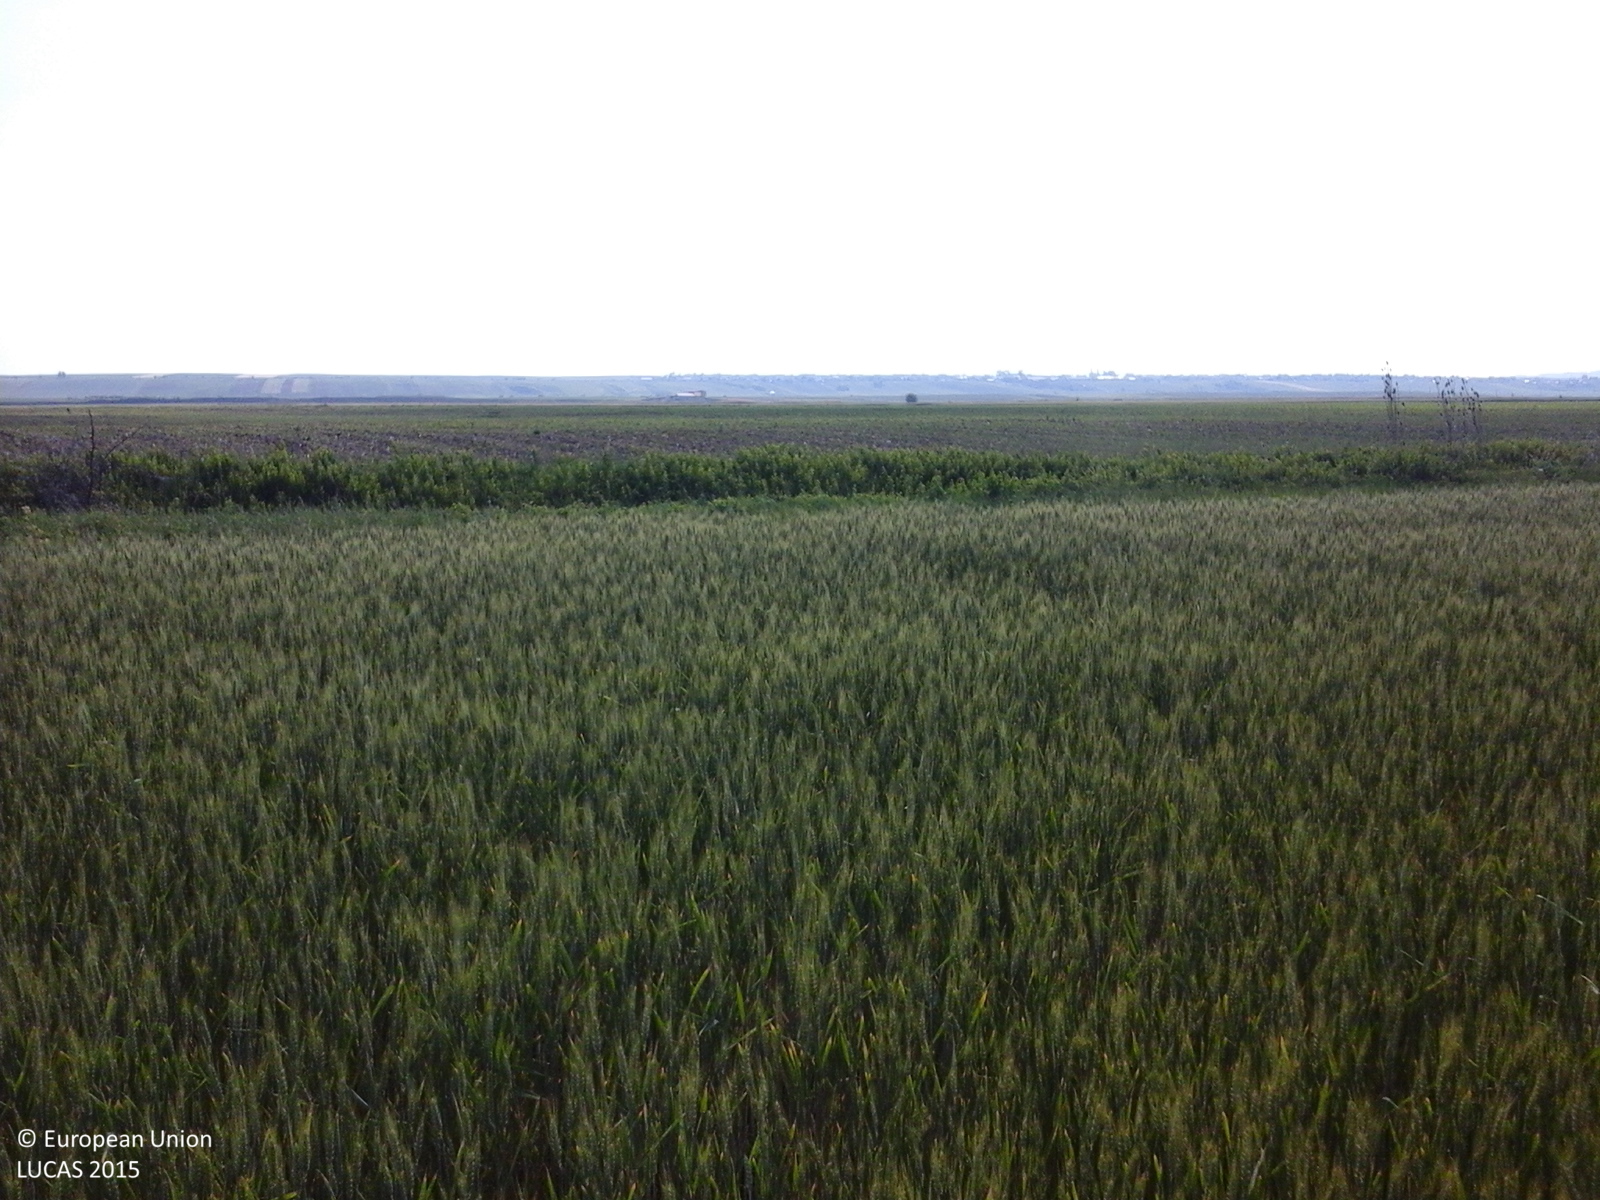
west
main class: Cropland
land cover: Durum wheat
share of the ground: > 75 %
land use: Agriculture (excluding fallow land and kitchen gardens)
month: June
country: RO
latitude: 47.0950
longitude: 26.8676
